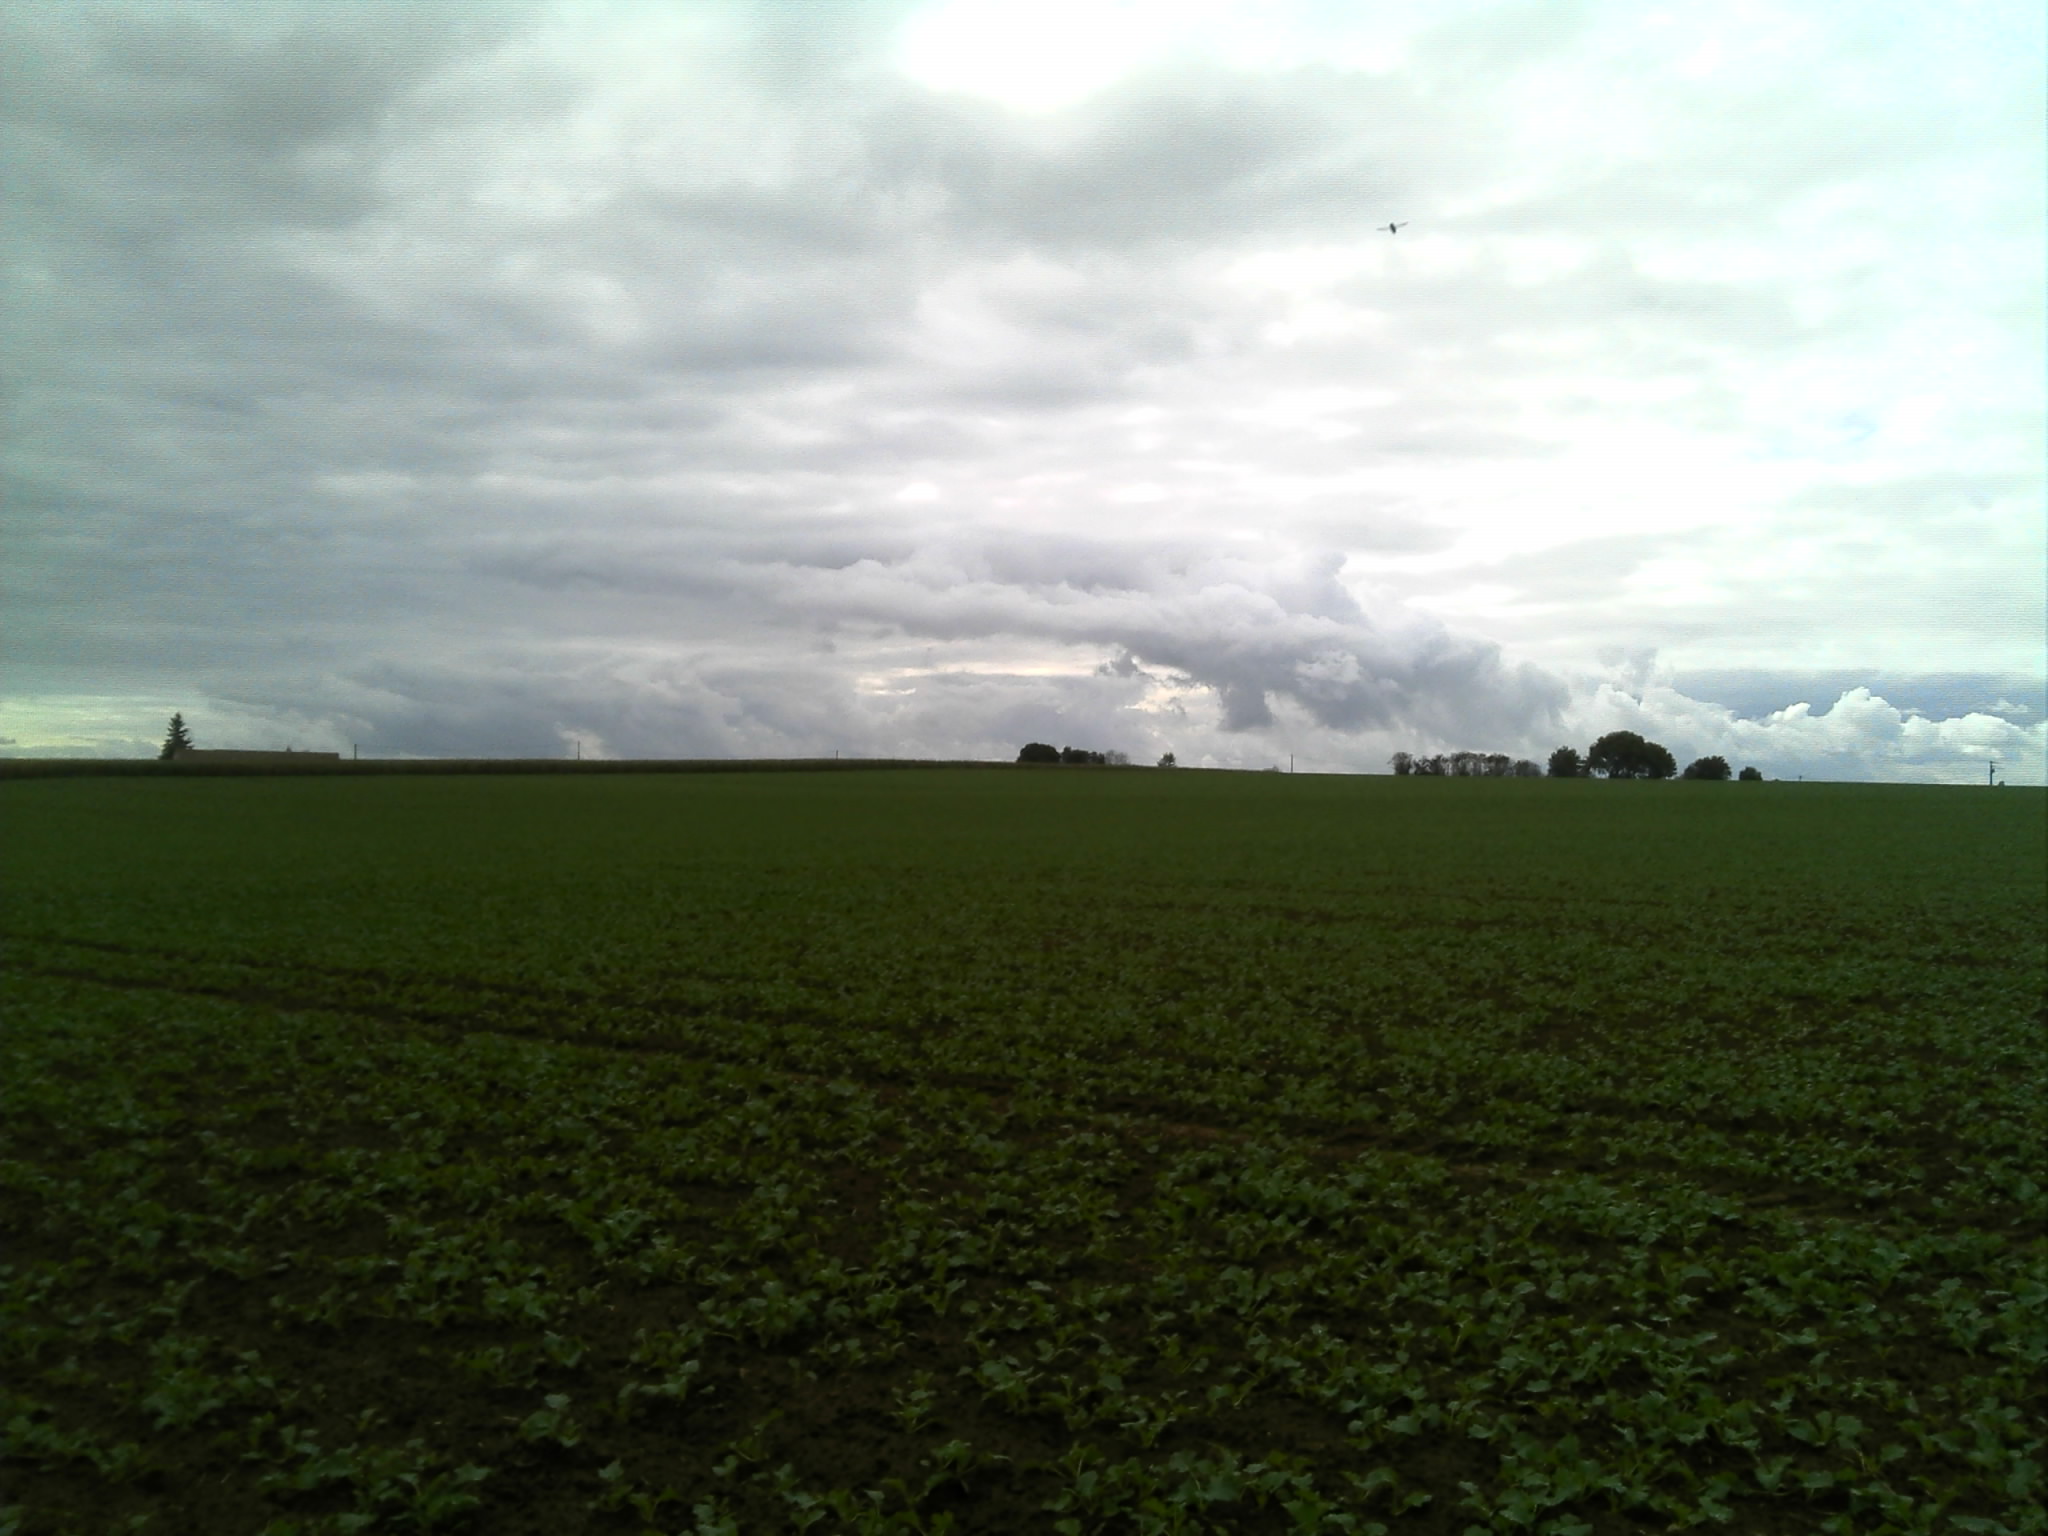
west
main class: Cropland
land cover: Rape and turnip rape
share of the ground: 50 - 75 %
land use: Agriculture (excluding fallow land and kitchen gardens)
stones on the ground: 10 - 25 %
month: October
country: FR
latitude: 48.0661
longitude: -0.1074
